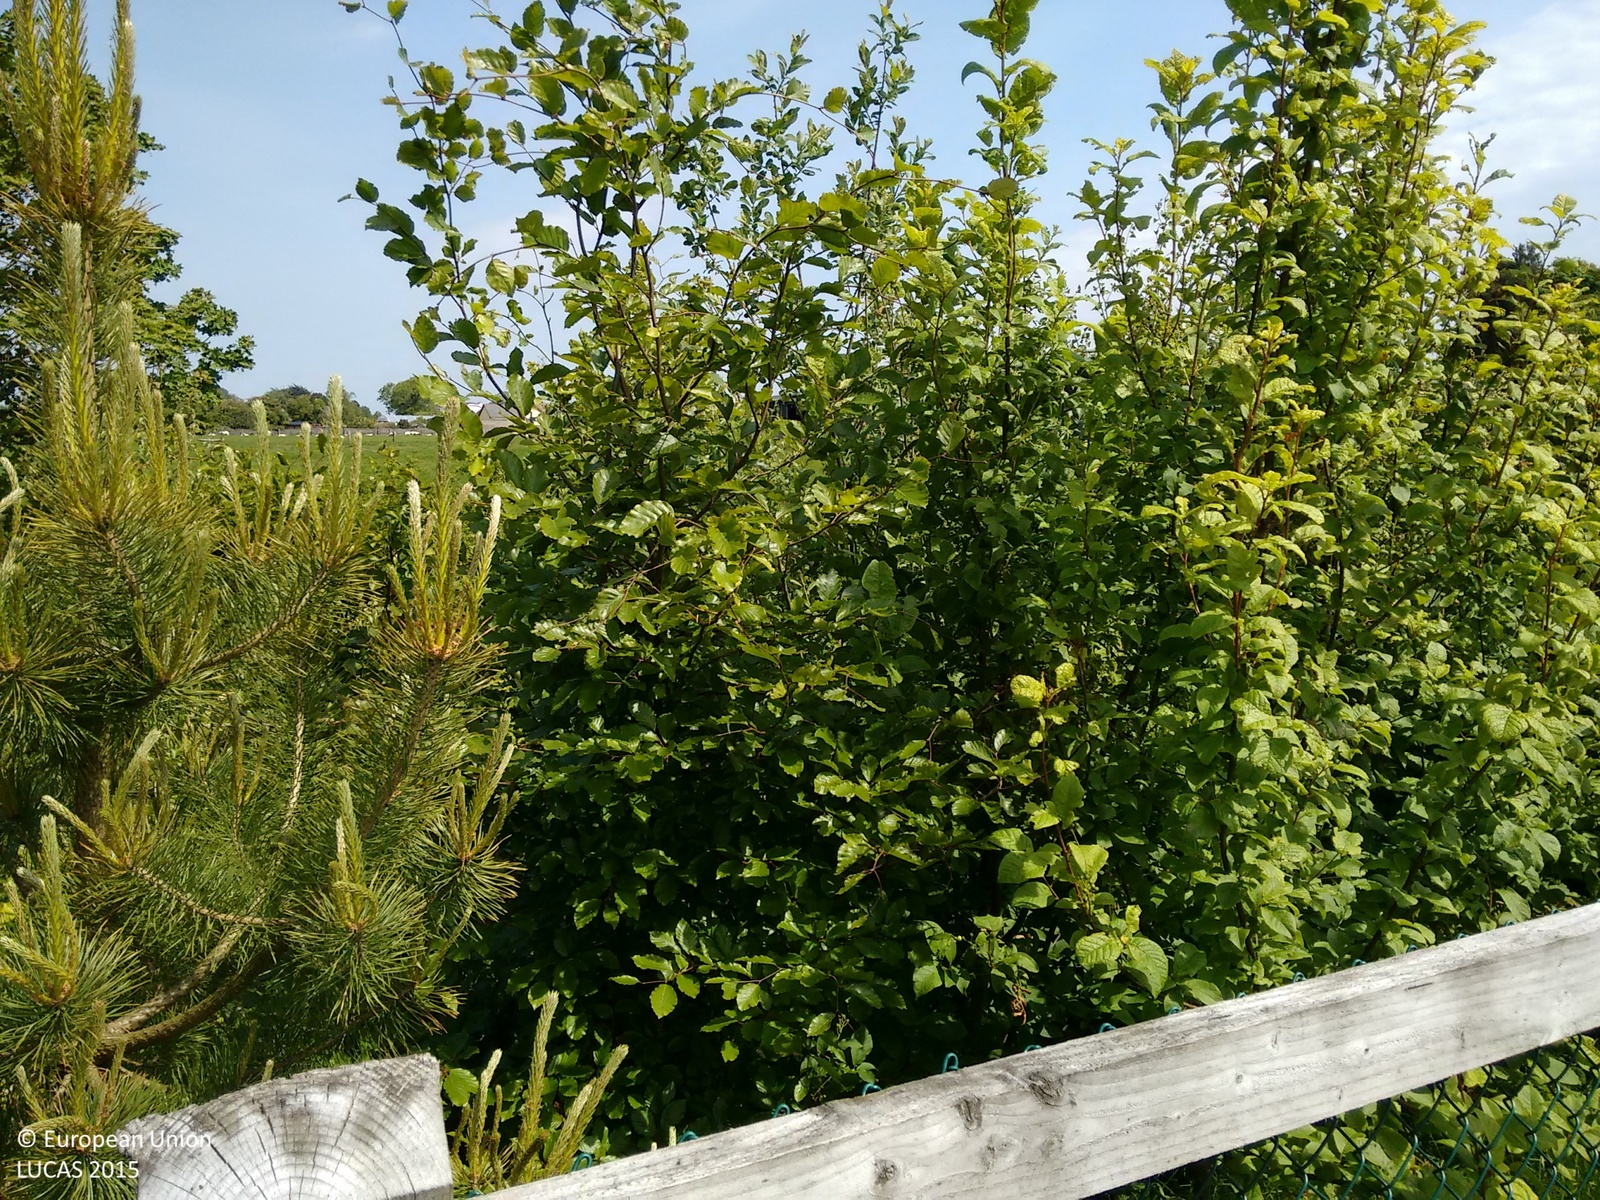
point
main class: Woodland
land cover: Broadleaved woodland
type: acidophilous oak and oak-birch forest
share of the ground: > 75 %
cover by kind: broadleaved forest trees 90 %, coniferous forest trees 10 %
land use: Road transport
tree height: < 5 m
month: June
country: IE
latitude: 53.5716
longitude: -6.5736
